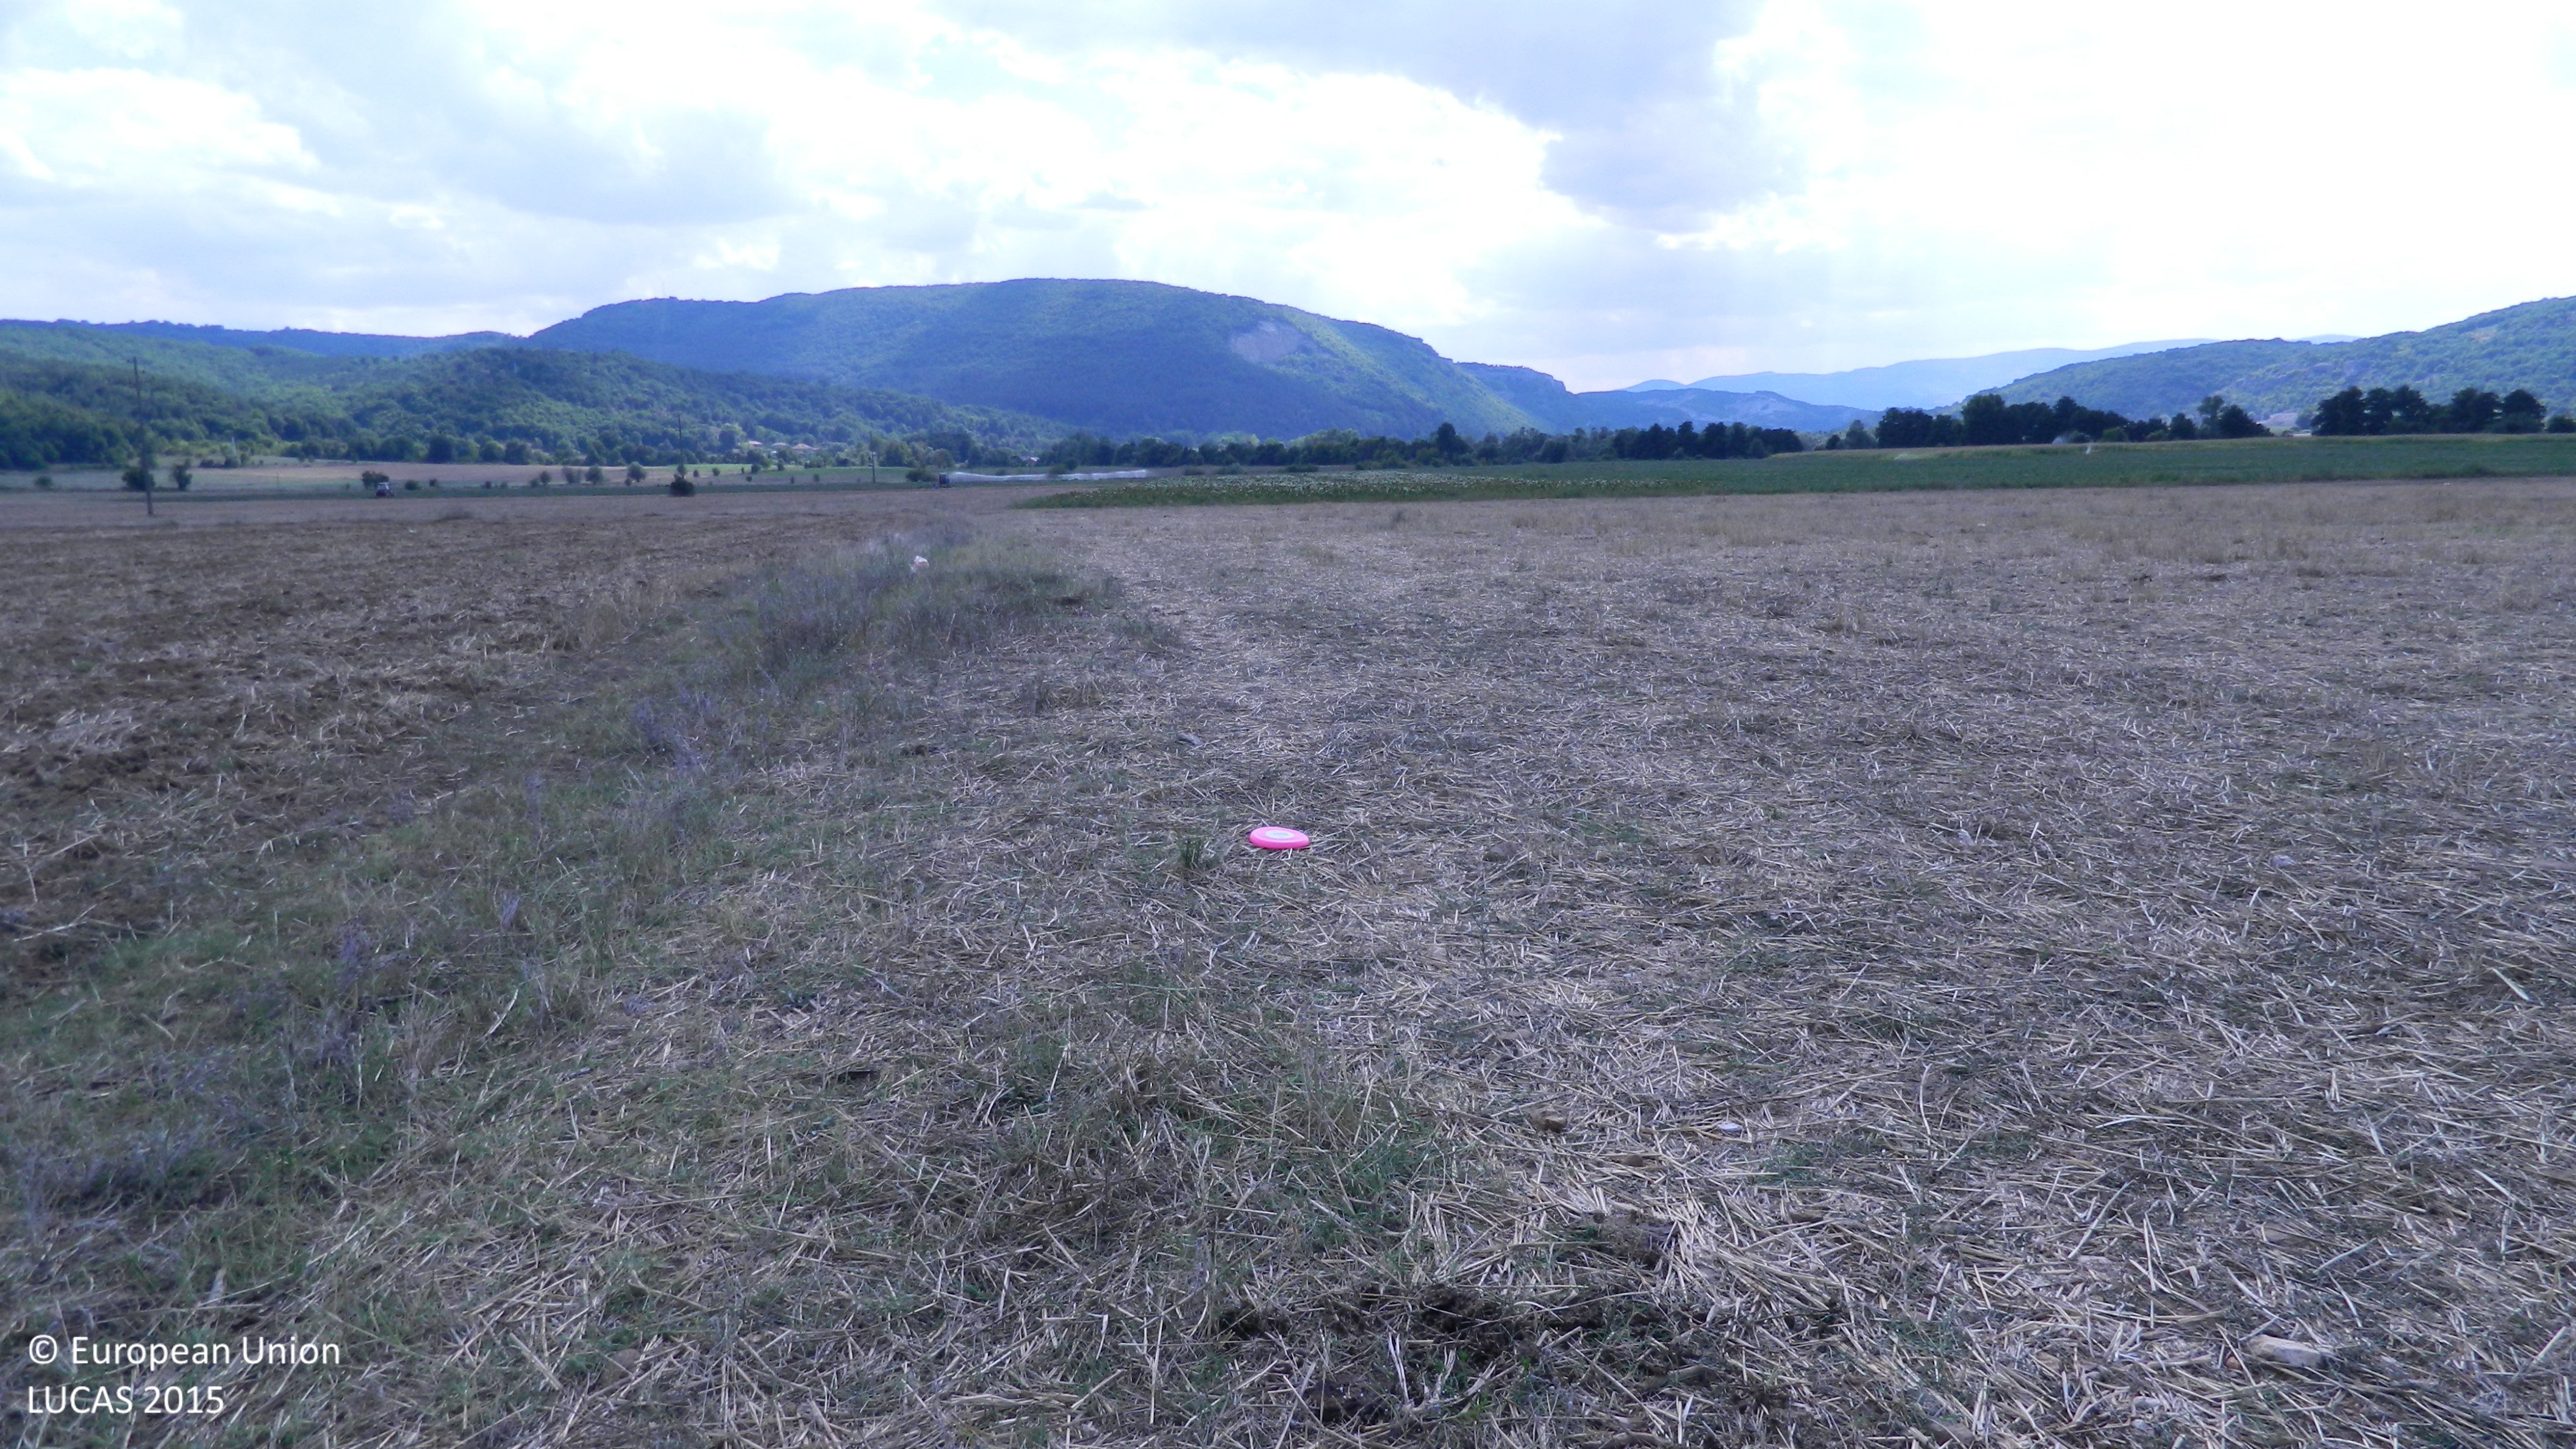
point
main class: Cropland
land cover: Common wheat
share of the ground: < 10 %
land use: Agriculture (excluding fallow land and kitchen gardens)
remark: Harvested field
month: August
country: BG
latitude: 41.6326
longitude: 25.7536
